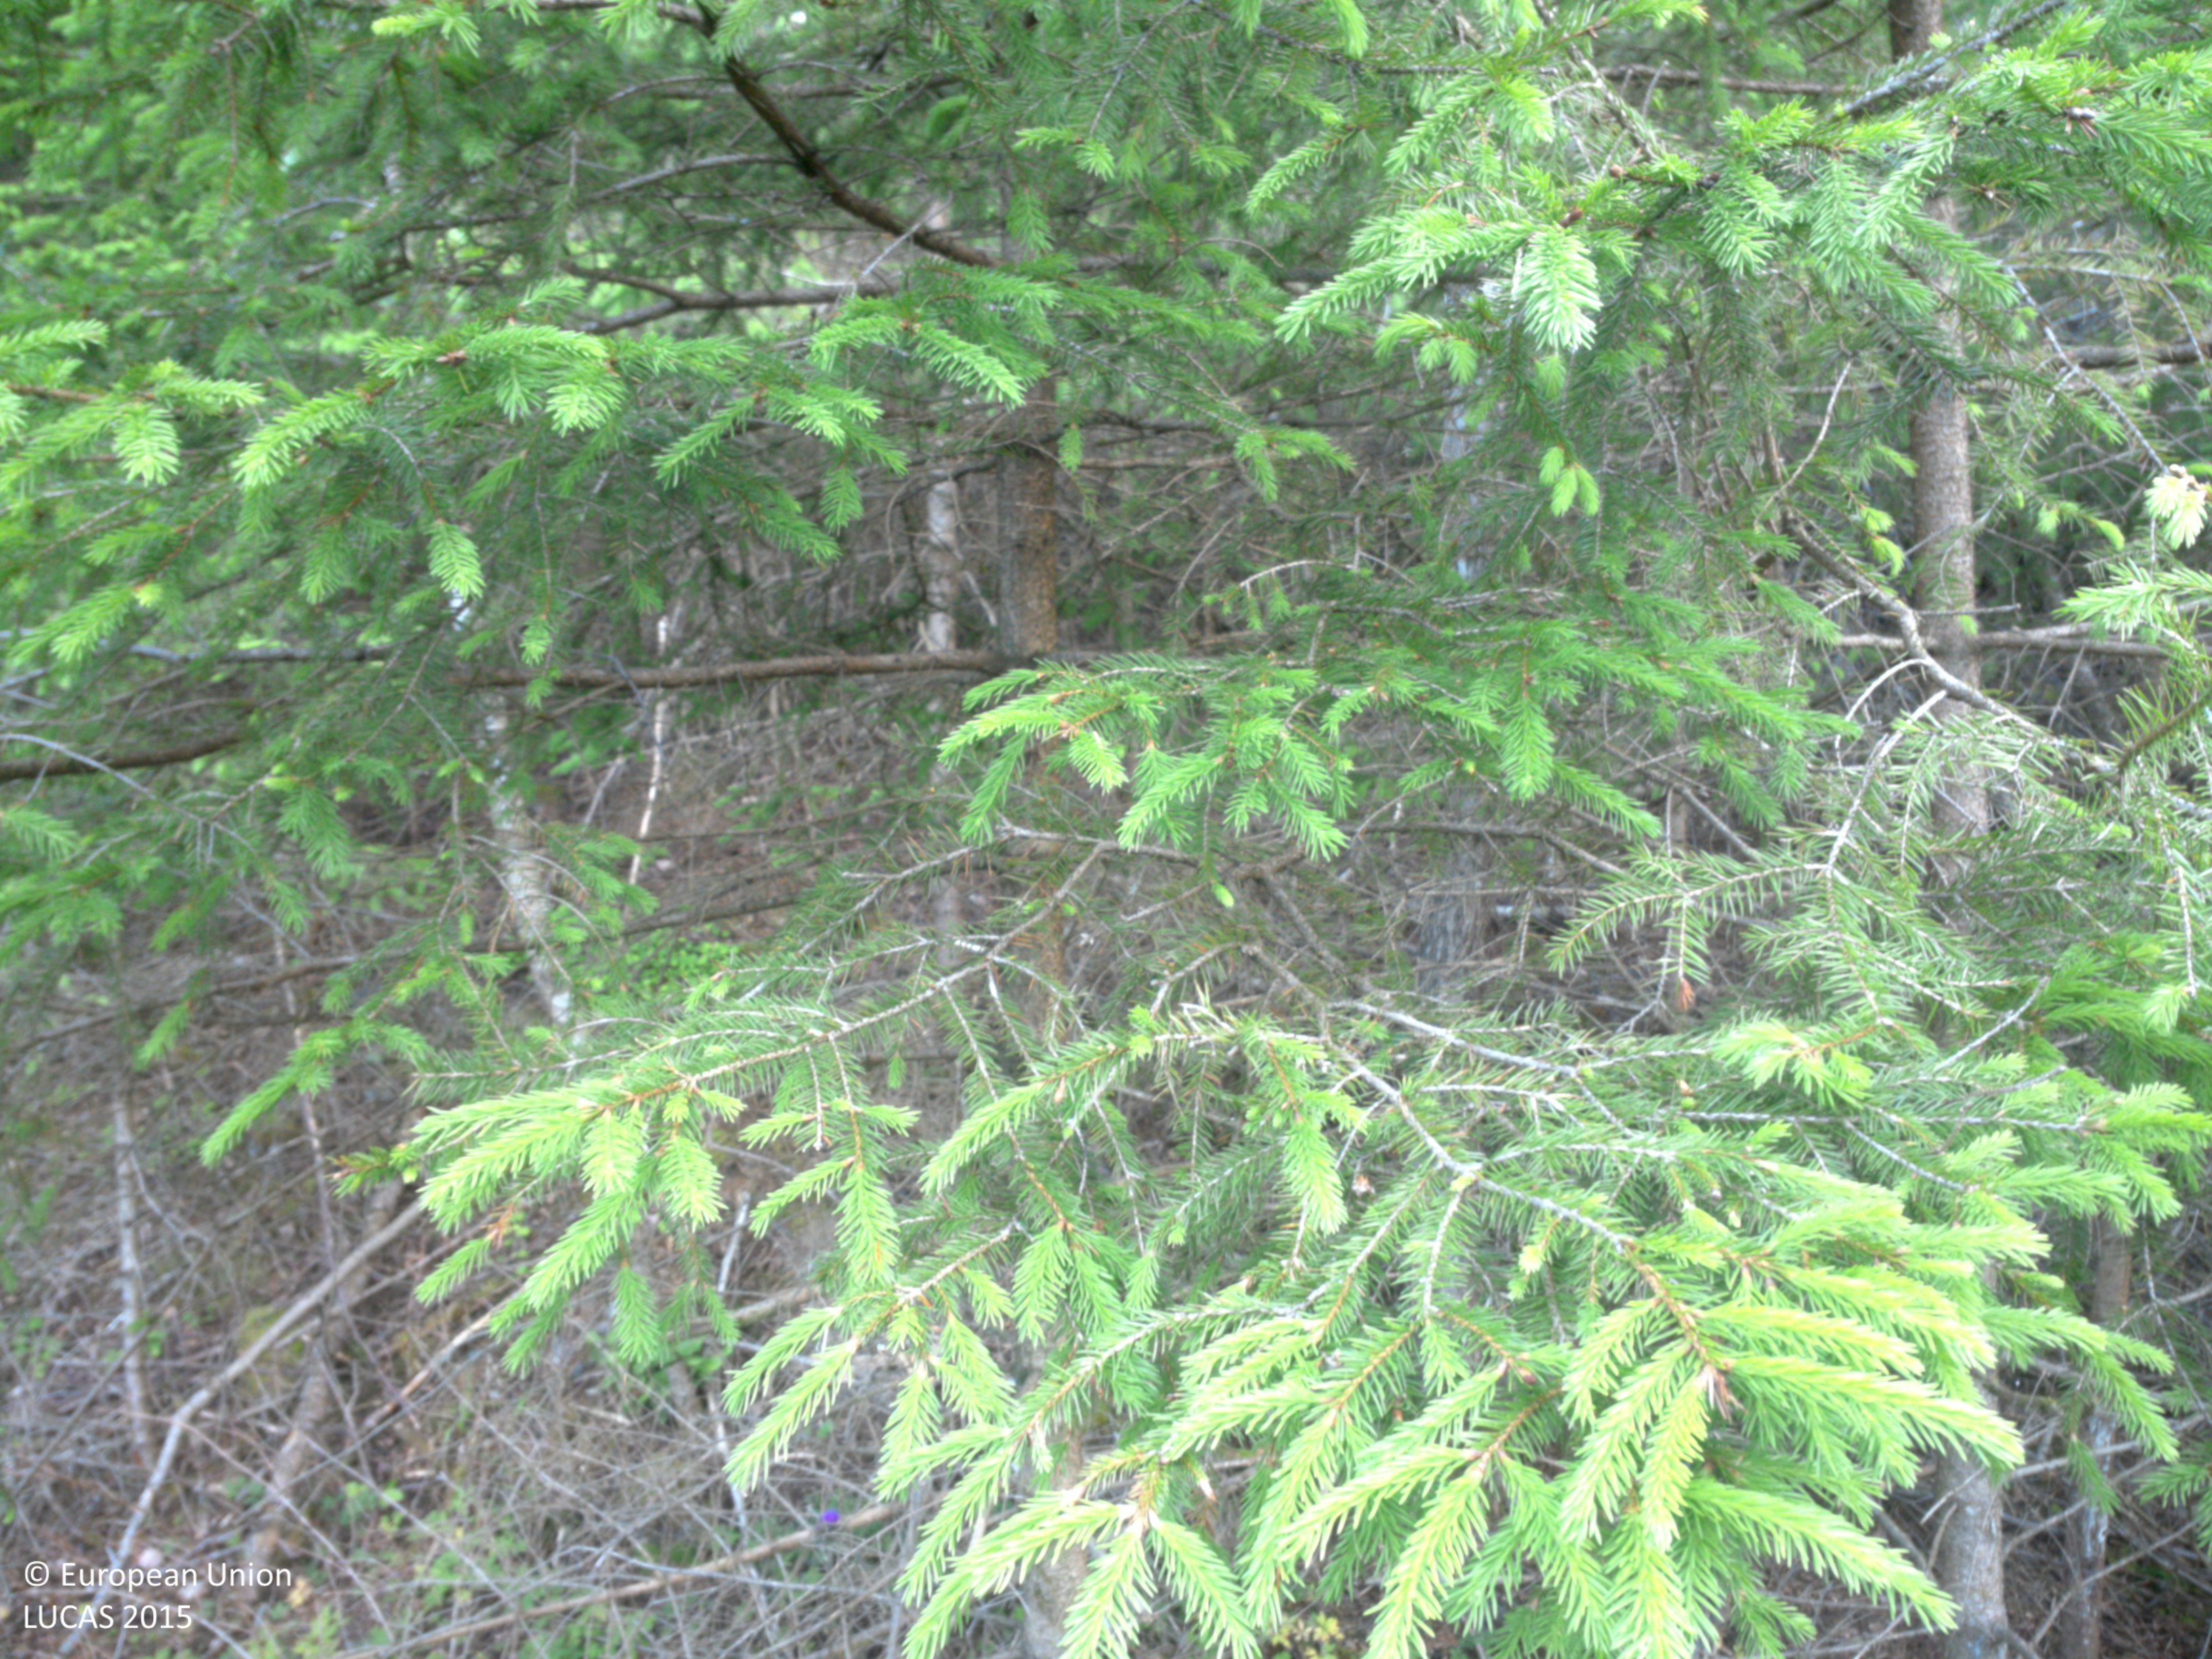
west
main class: Woodland
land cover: Spruce dominated mixed woodland
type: boreal forest
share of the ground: 25 - 50 %
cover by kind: herbaceous plants 40 %, coniferous forest trees 30 %, broadleaved forest trees 15 %, shrubs 15 %
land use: Forestry
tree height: < 5 m
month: June
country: SE
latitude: 58.8224
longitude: 11.5378
